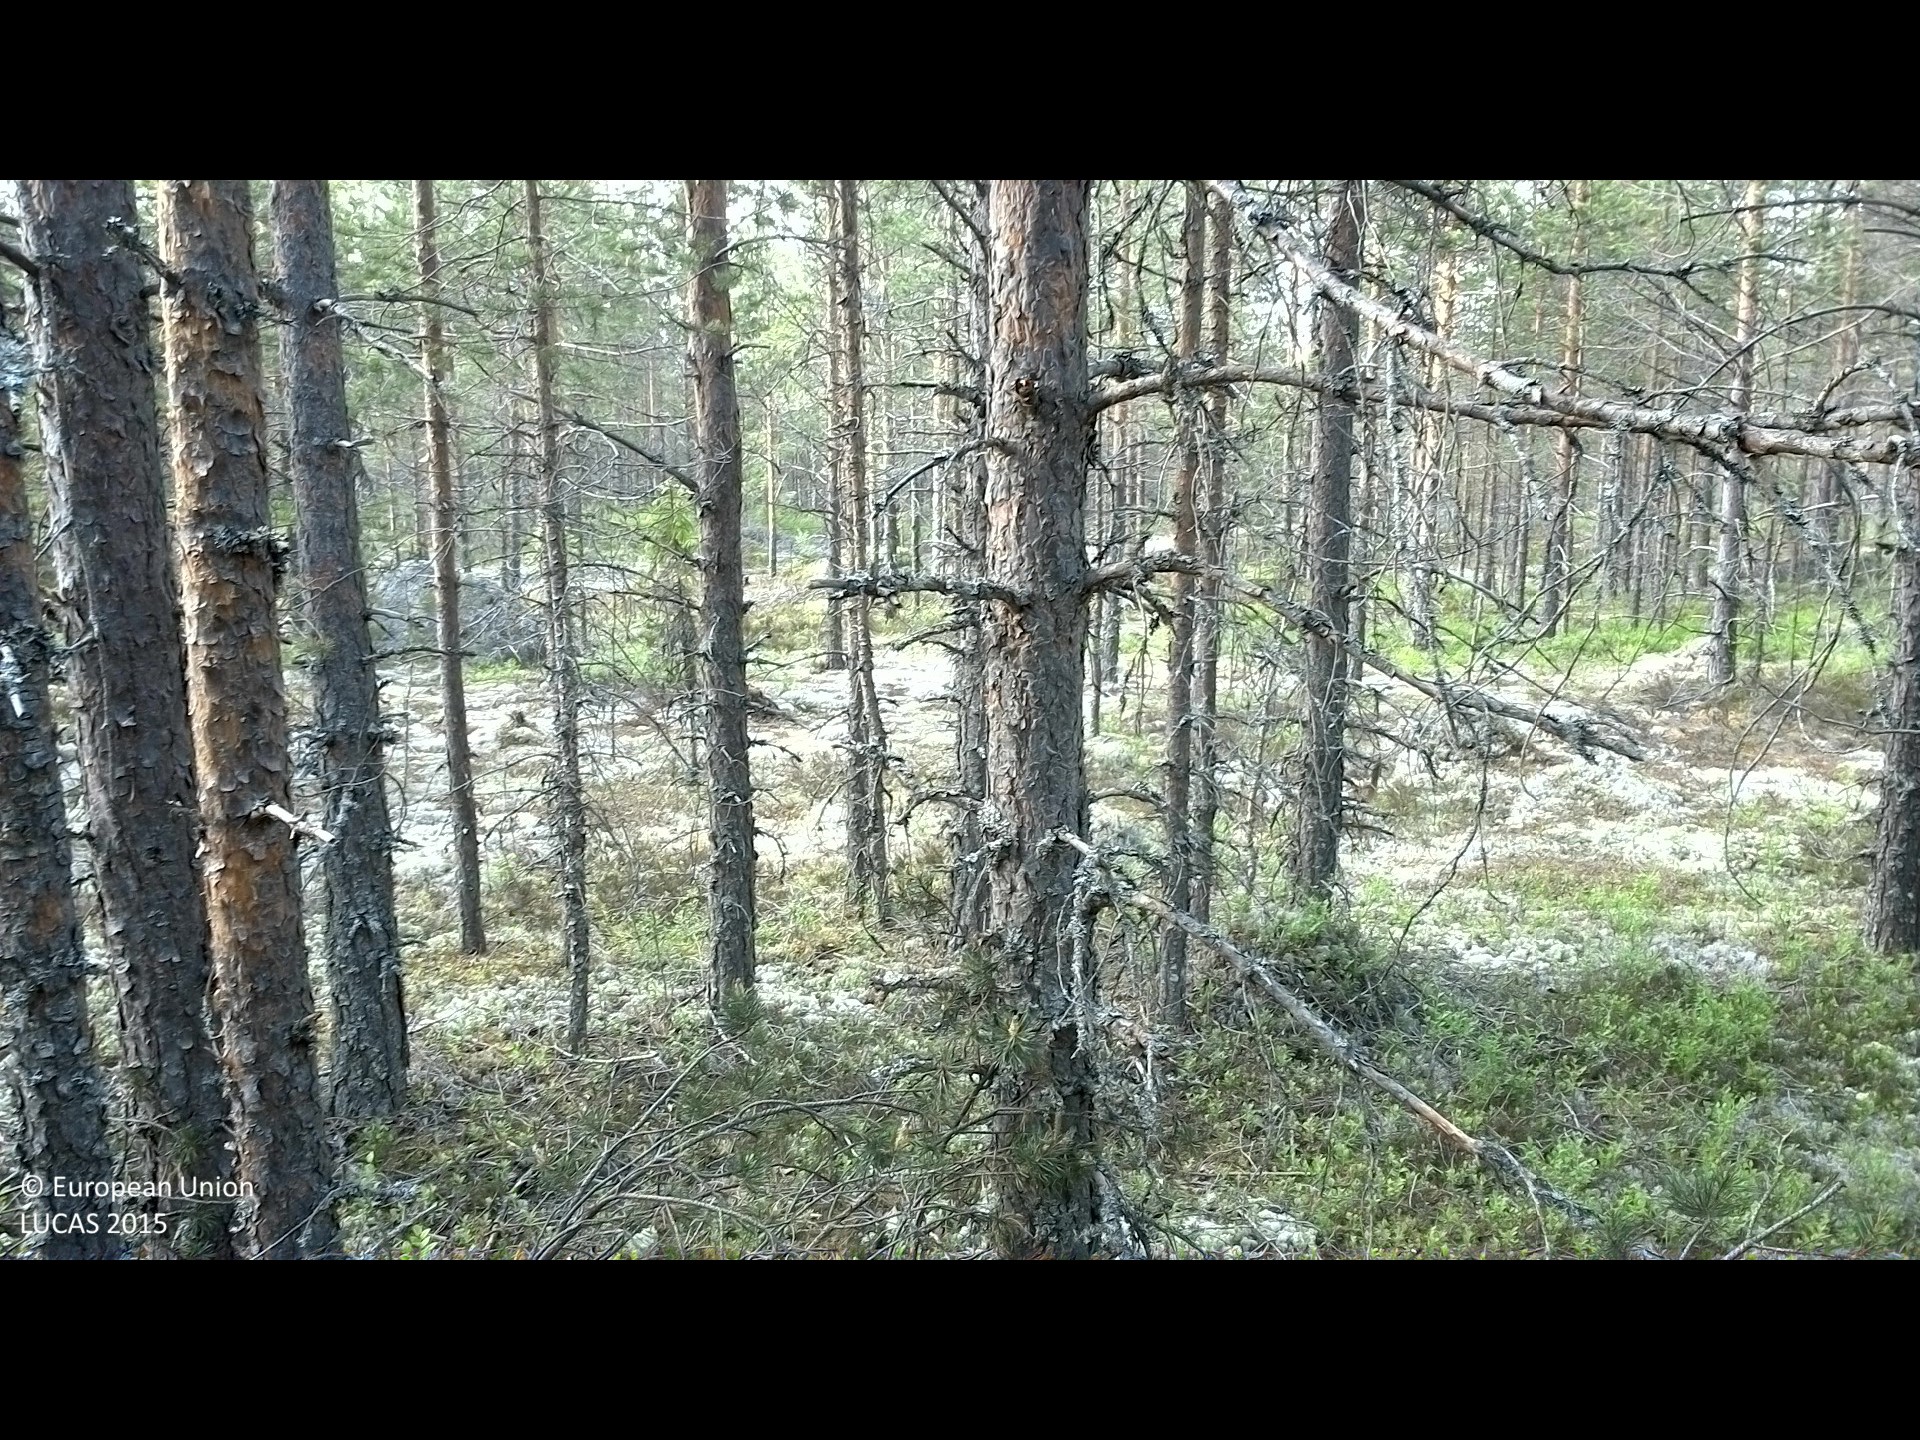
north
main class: Woodland
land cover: Pine dominated coniferous woodland
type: boreal forest
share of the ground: 25 - 50 %
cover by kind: lichens and mosses 50 %, coniferous forest trees 30 %, shrubs 20 %
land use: Forestry
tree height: > 5 m
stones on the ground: < 10 %
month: June
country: SE
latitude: 61.9576
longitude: 16.6747
